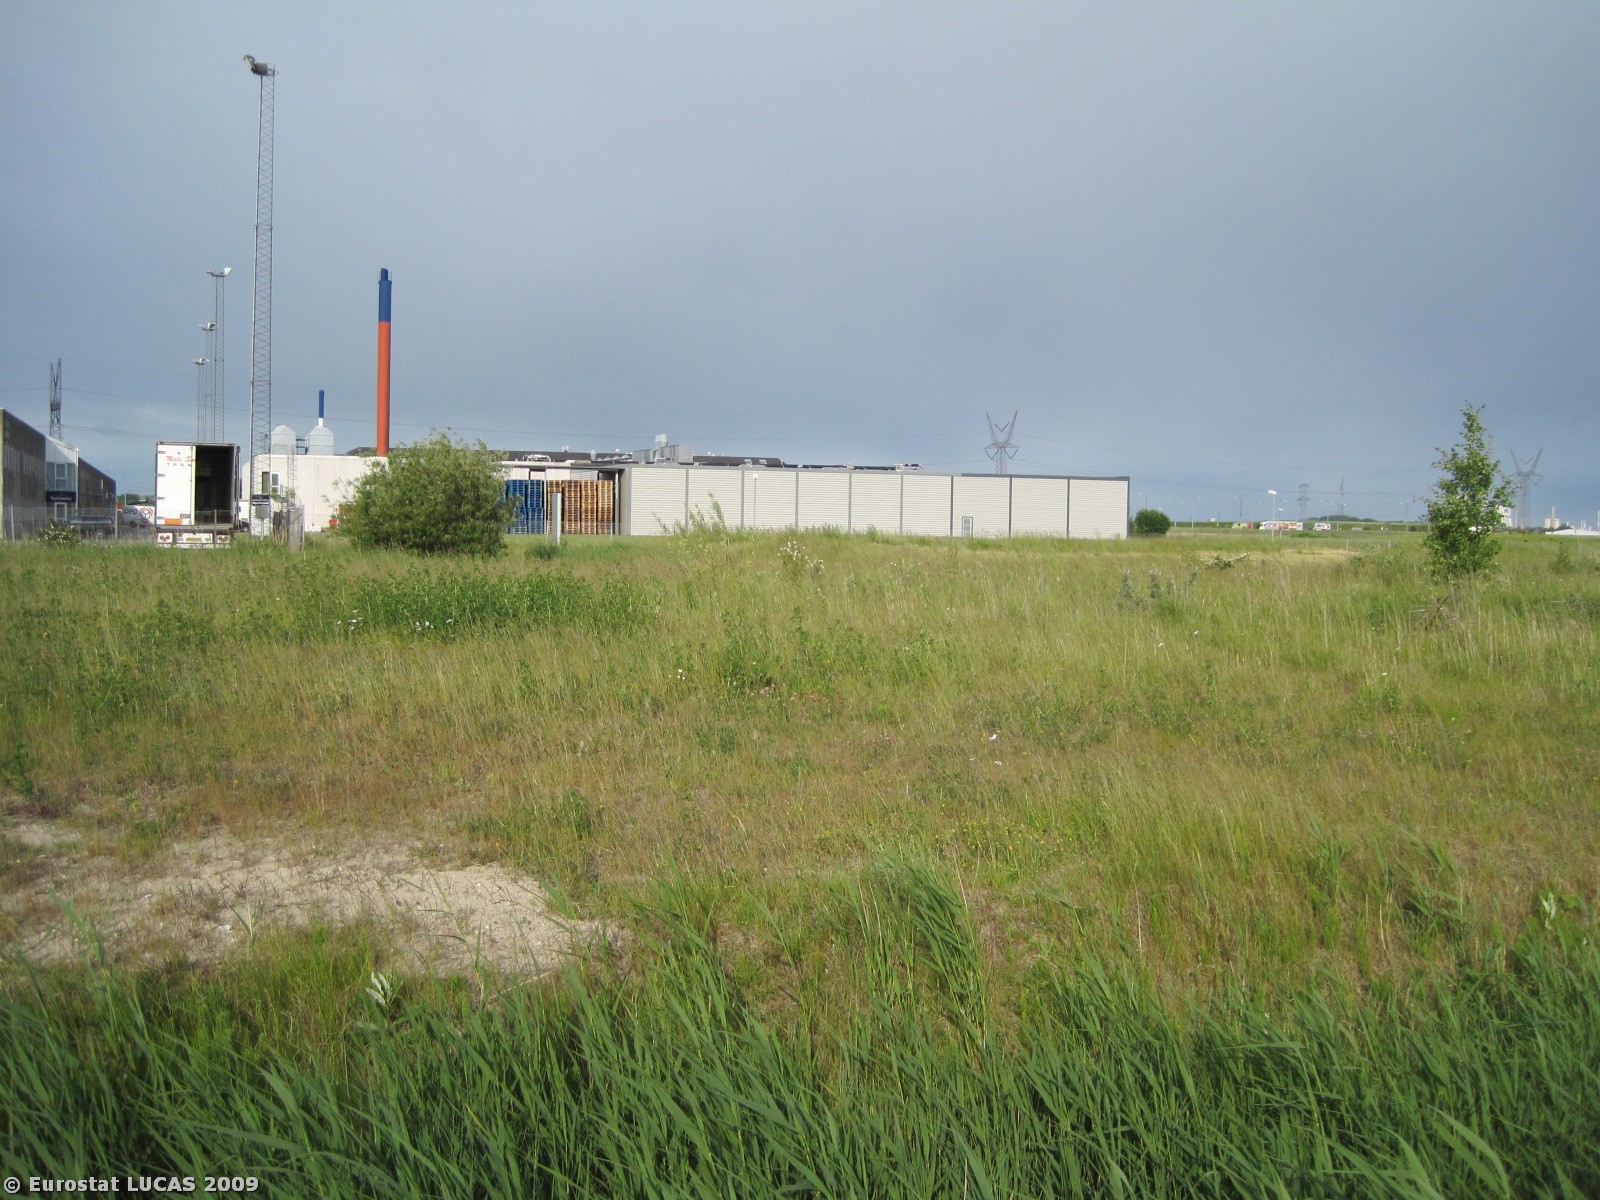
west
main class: Grassland
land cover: Grassland without tree/shrub cover
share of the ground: > 75 %
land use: Unused
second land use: Manufacturing of food, beverages and tobacco products
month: June
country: DK
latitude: 57.0506
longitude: 10.0494
